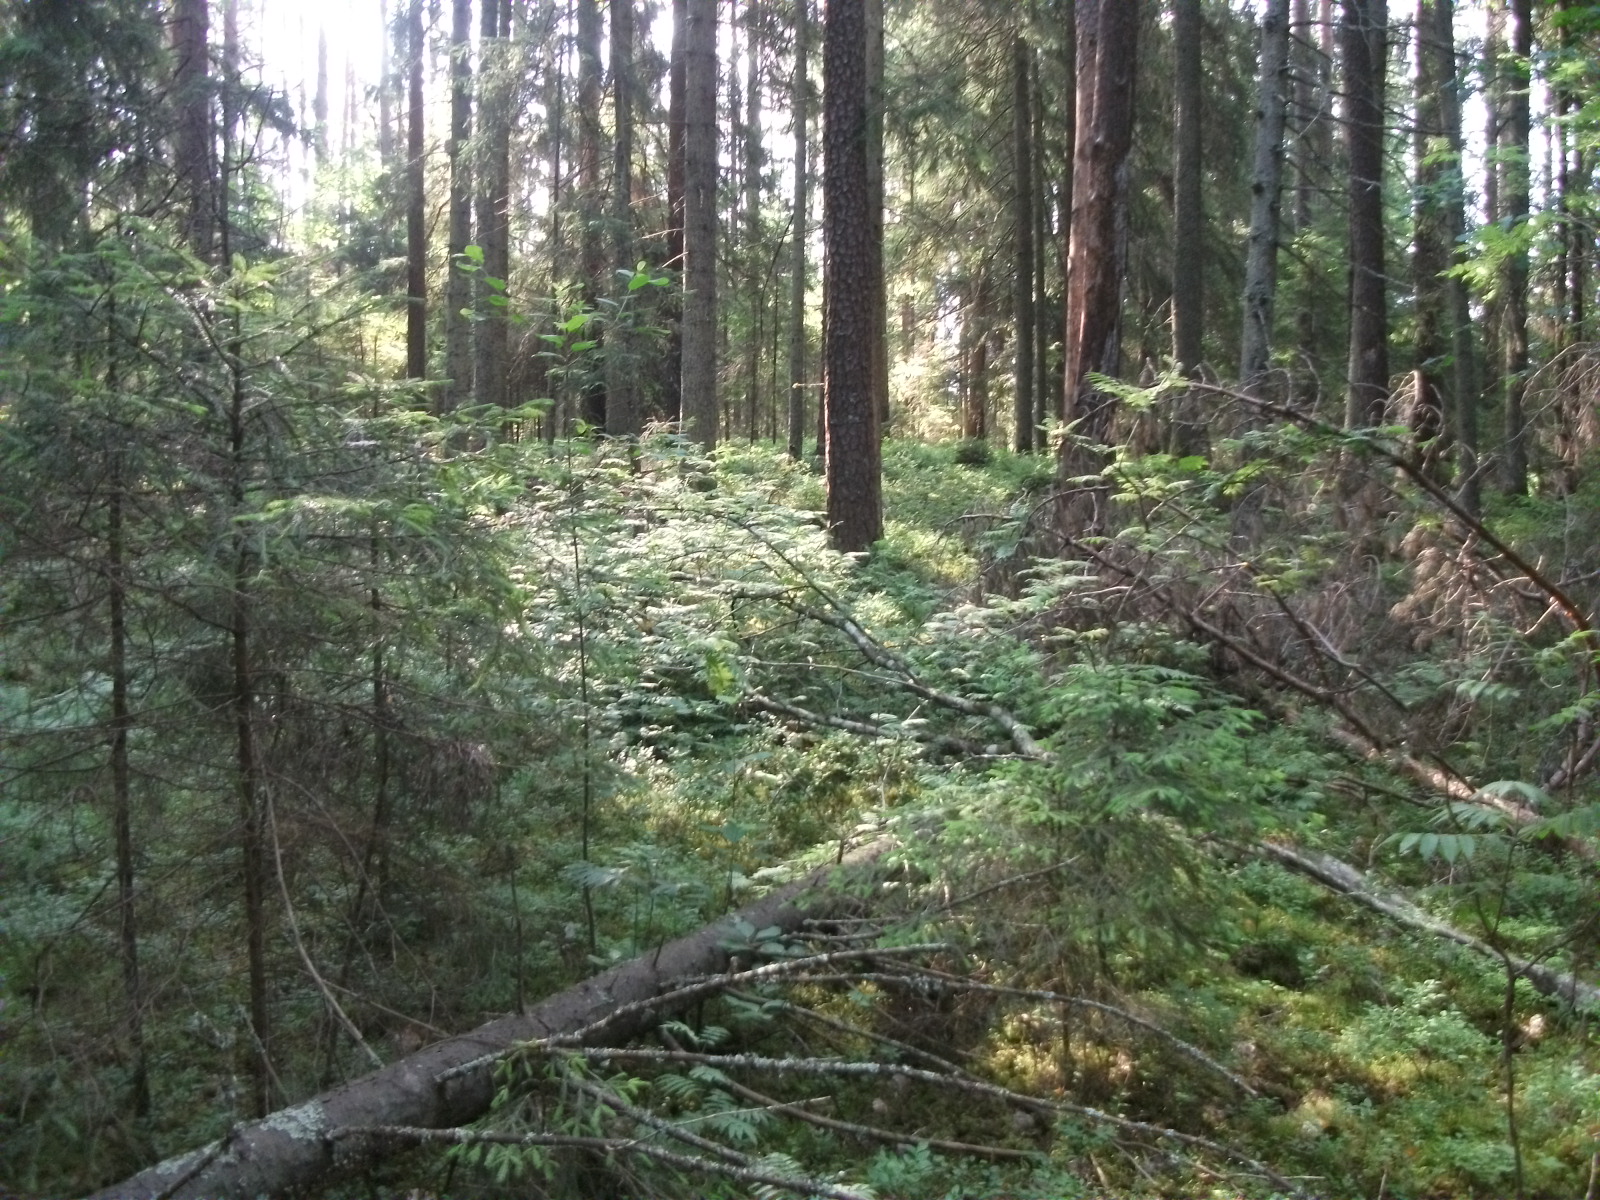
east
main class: Woodland
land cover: Other coniferous woodland
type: hemiboreal forest and nemoral coniferous forest and mixed broadleaved-coniferous forest
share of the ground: > 75 %
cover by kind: coniferous forest trees 85 %, shrubs 10 %, lichens and mosses 5 %
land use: Forestry
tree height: > 5 m
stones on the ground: < 10 %
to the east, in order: Other coniferous woodland; Spruce dominated mixed woodland; Tracks; Broadleaved woodland
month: July
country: LV
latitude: 57.1516
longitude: 26.3562
